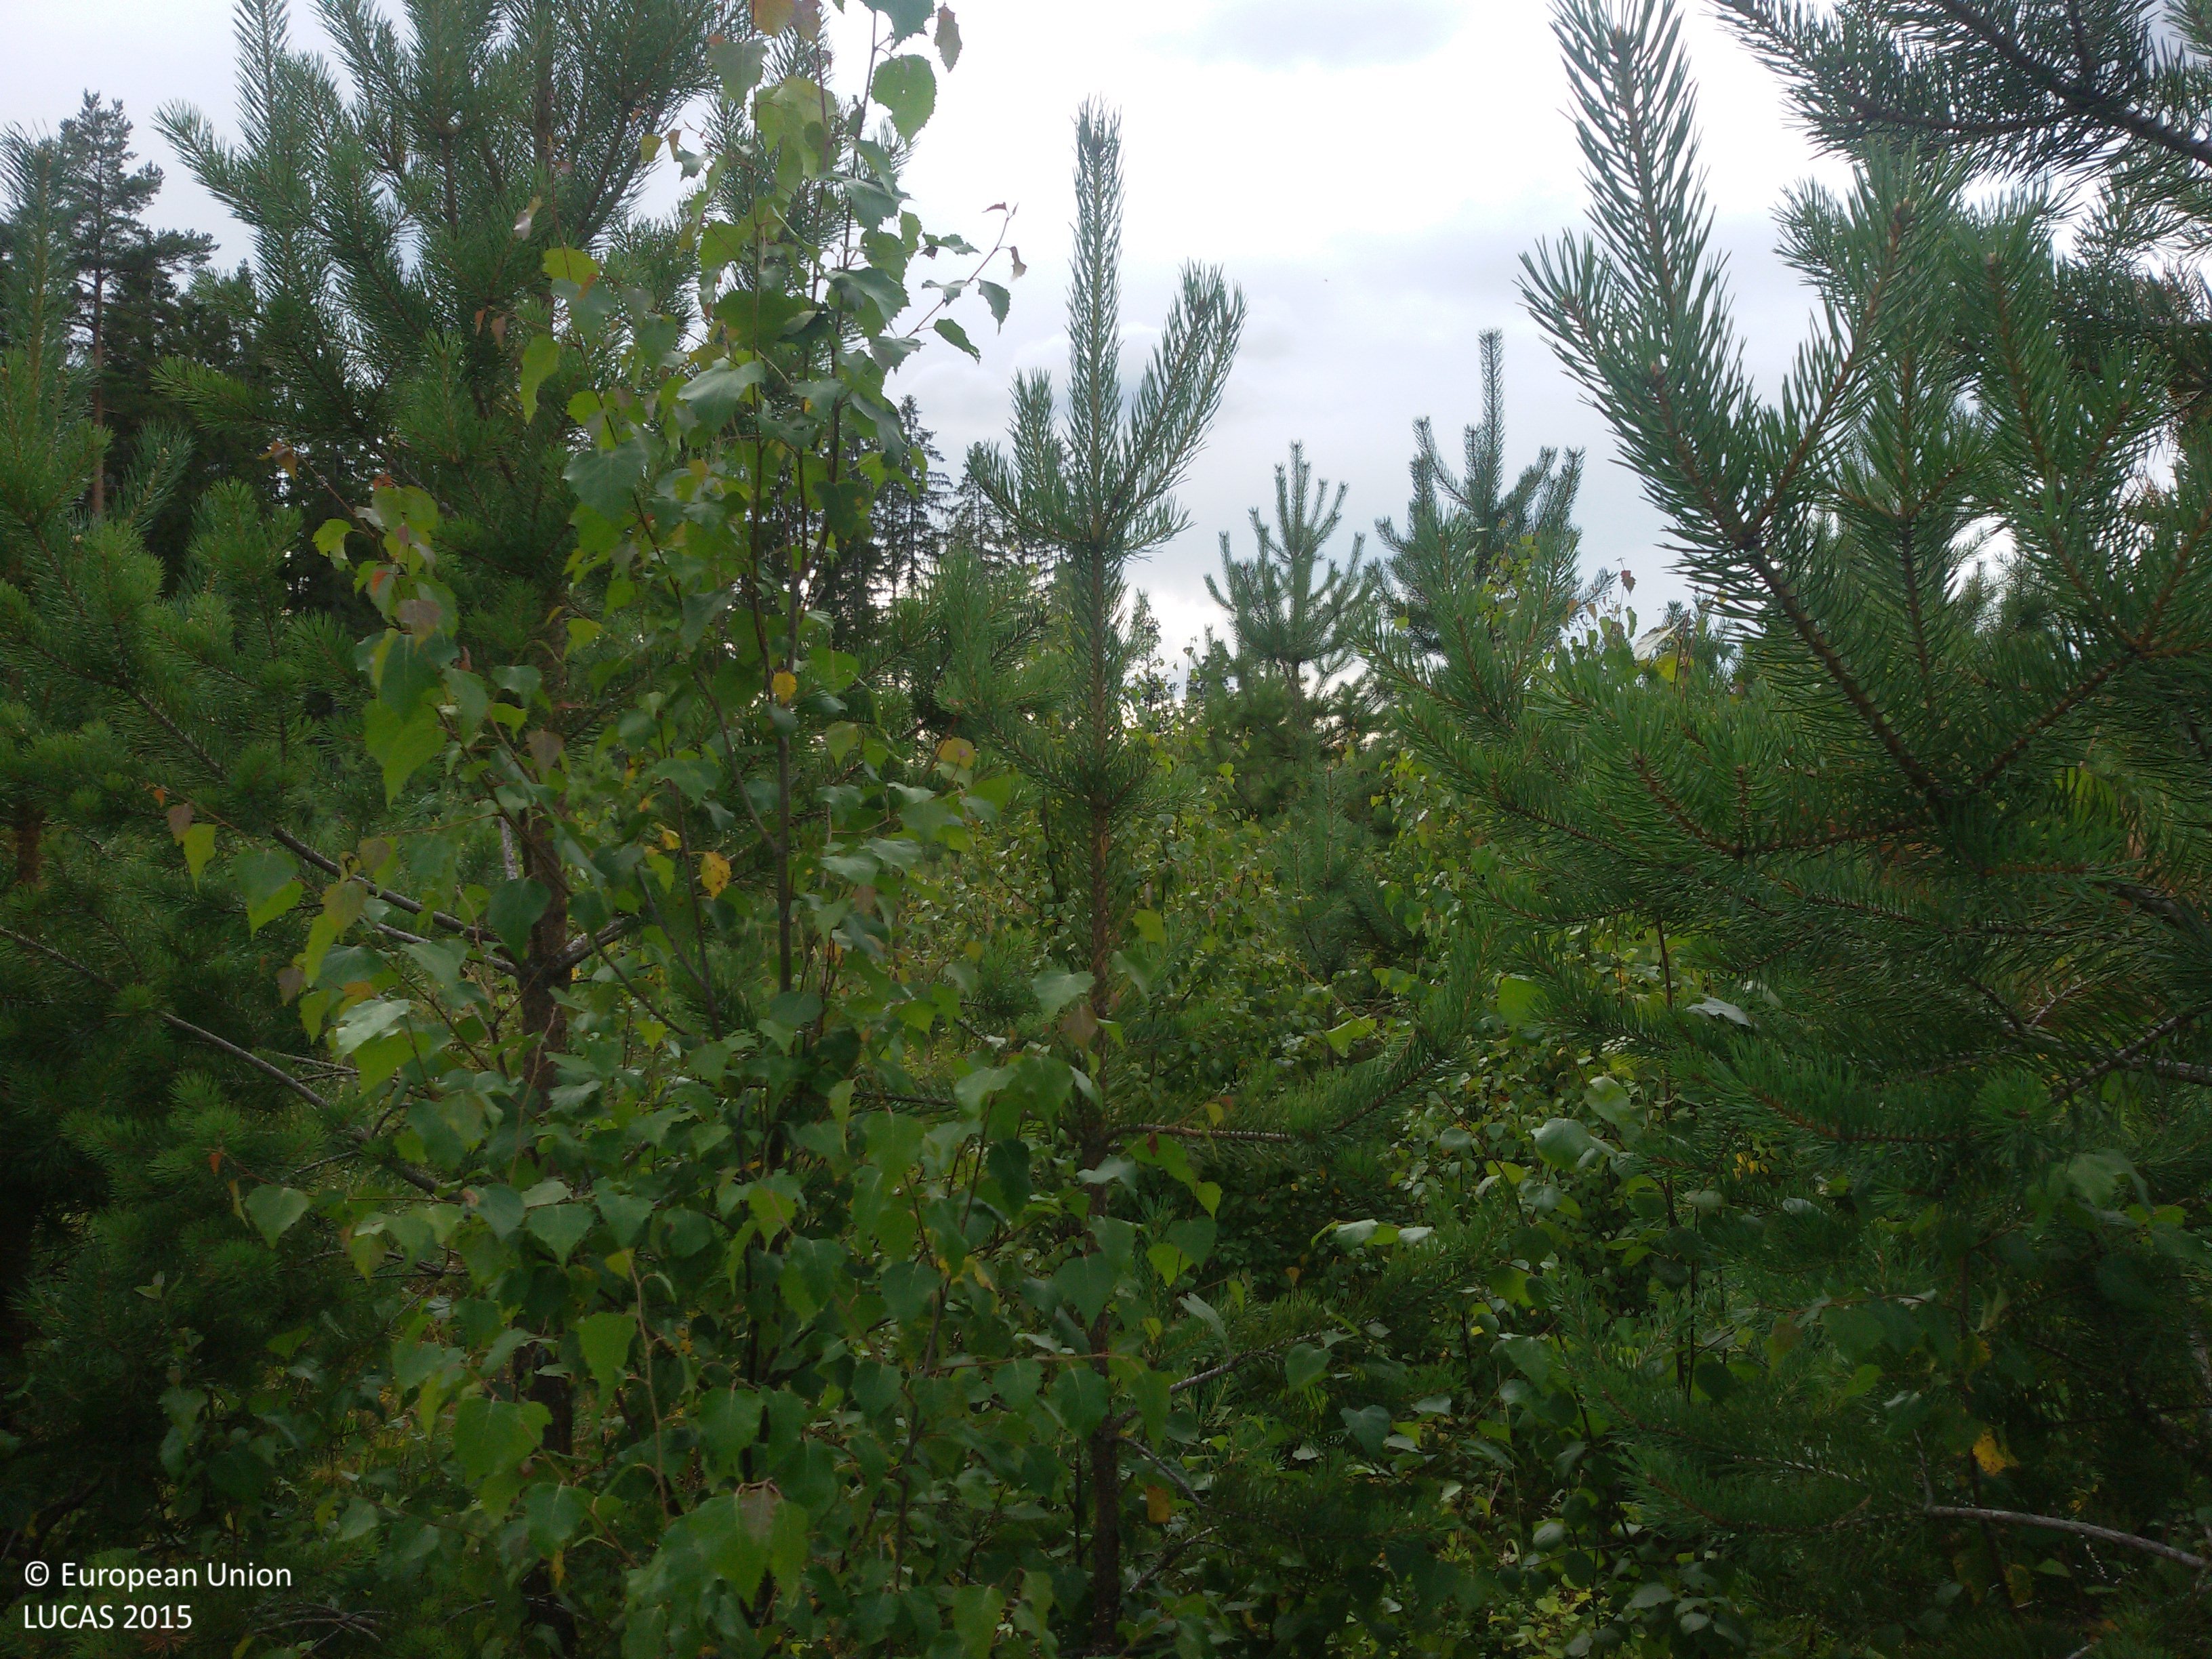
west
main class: Woodland
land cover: Pine dominated mixed woodland
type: boreal forest
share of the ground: > 75 %
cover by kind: coniferous forest trees 45 %, broadleaved forest trees 40 %, herbaceous plants 15 %
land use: Forestry
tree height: < 5 m
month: August
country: SE
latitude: 60.4100
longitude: 16.5067
